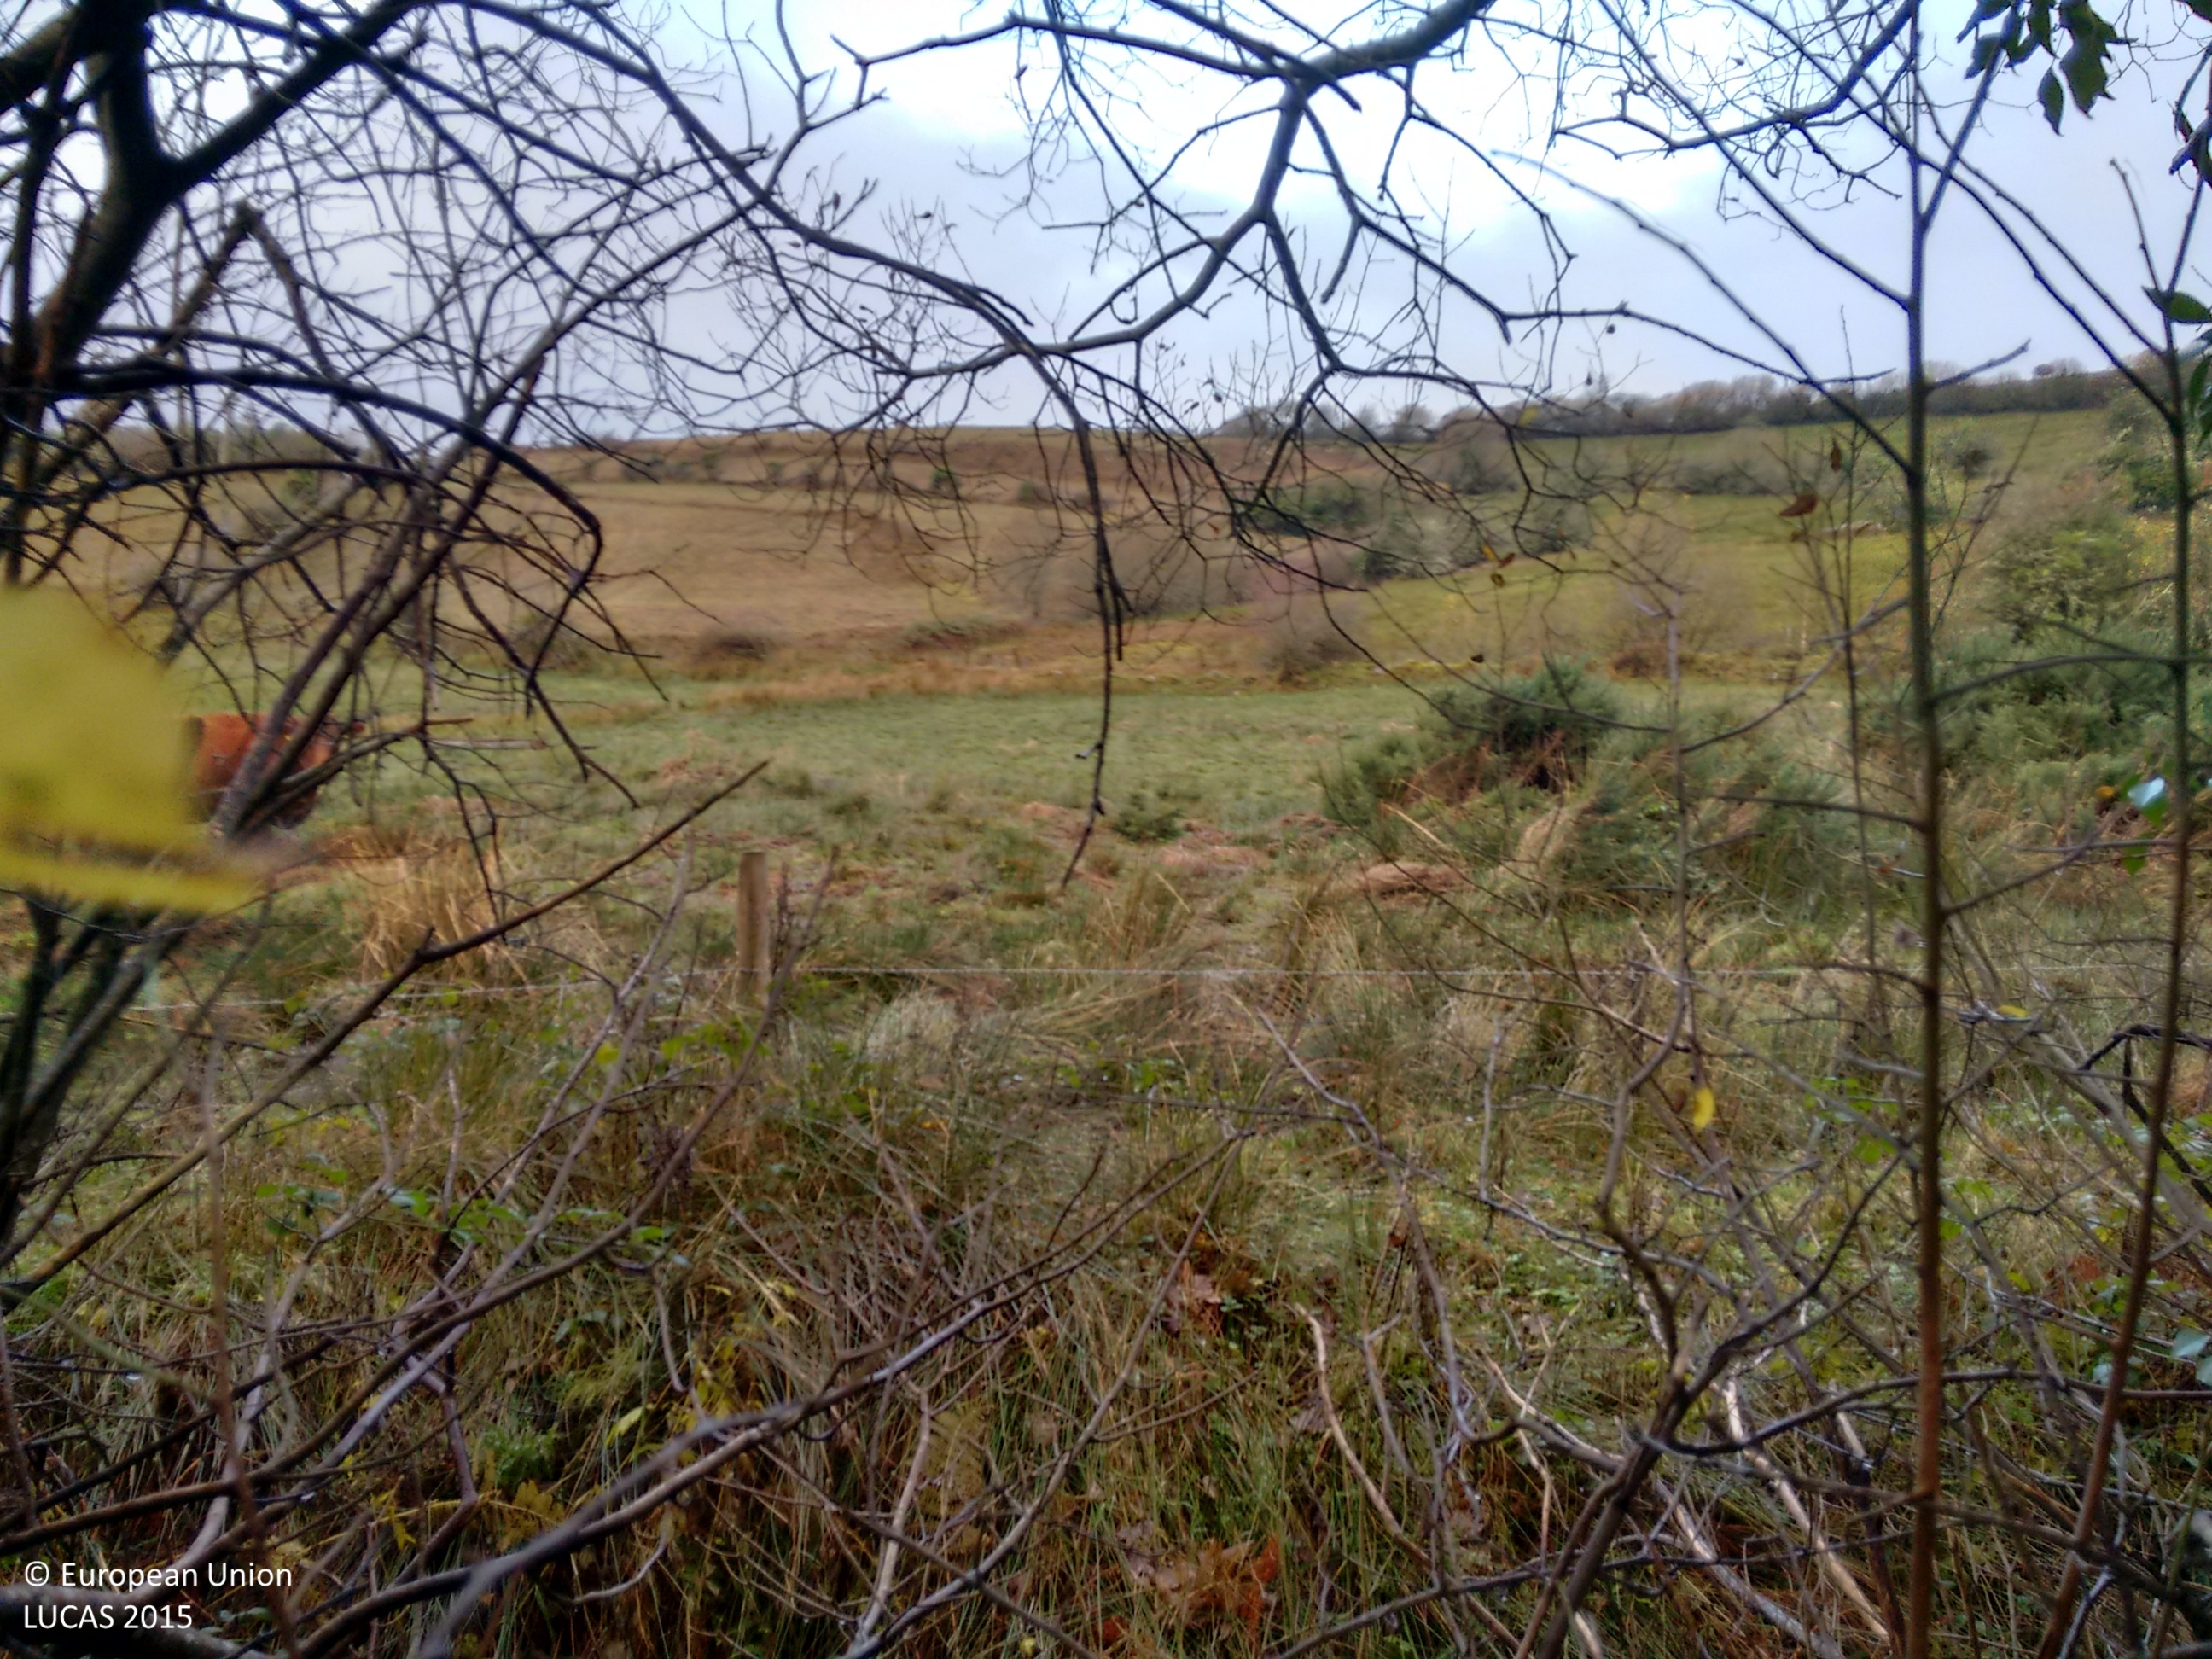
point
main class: Grassland
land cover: Grassland without tree/shrub cover
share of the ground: > 75 %
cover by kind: herbaceous plants 100 %
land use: Agriculture (excluding fallow land and kitchen gardens)
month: December
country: IE
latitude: 54.2134
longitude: -8.0077
